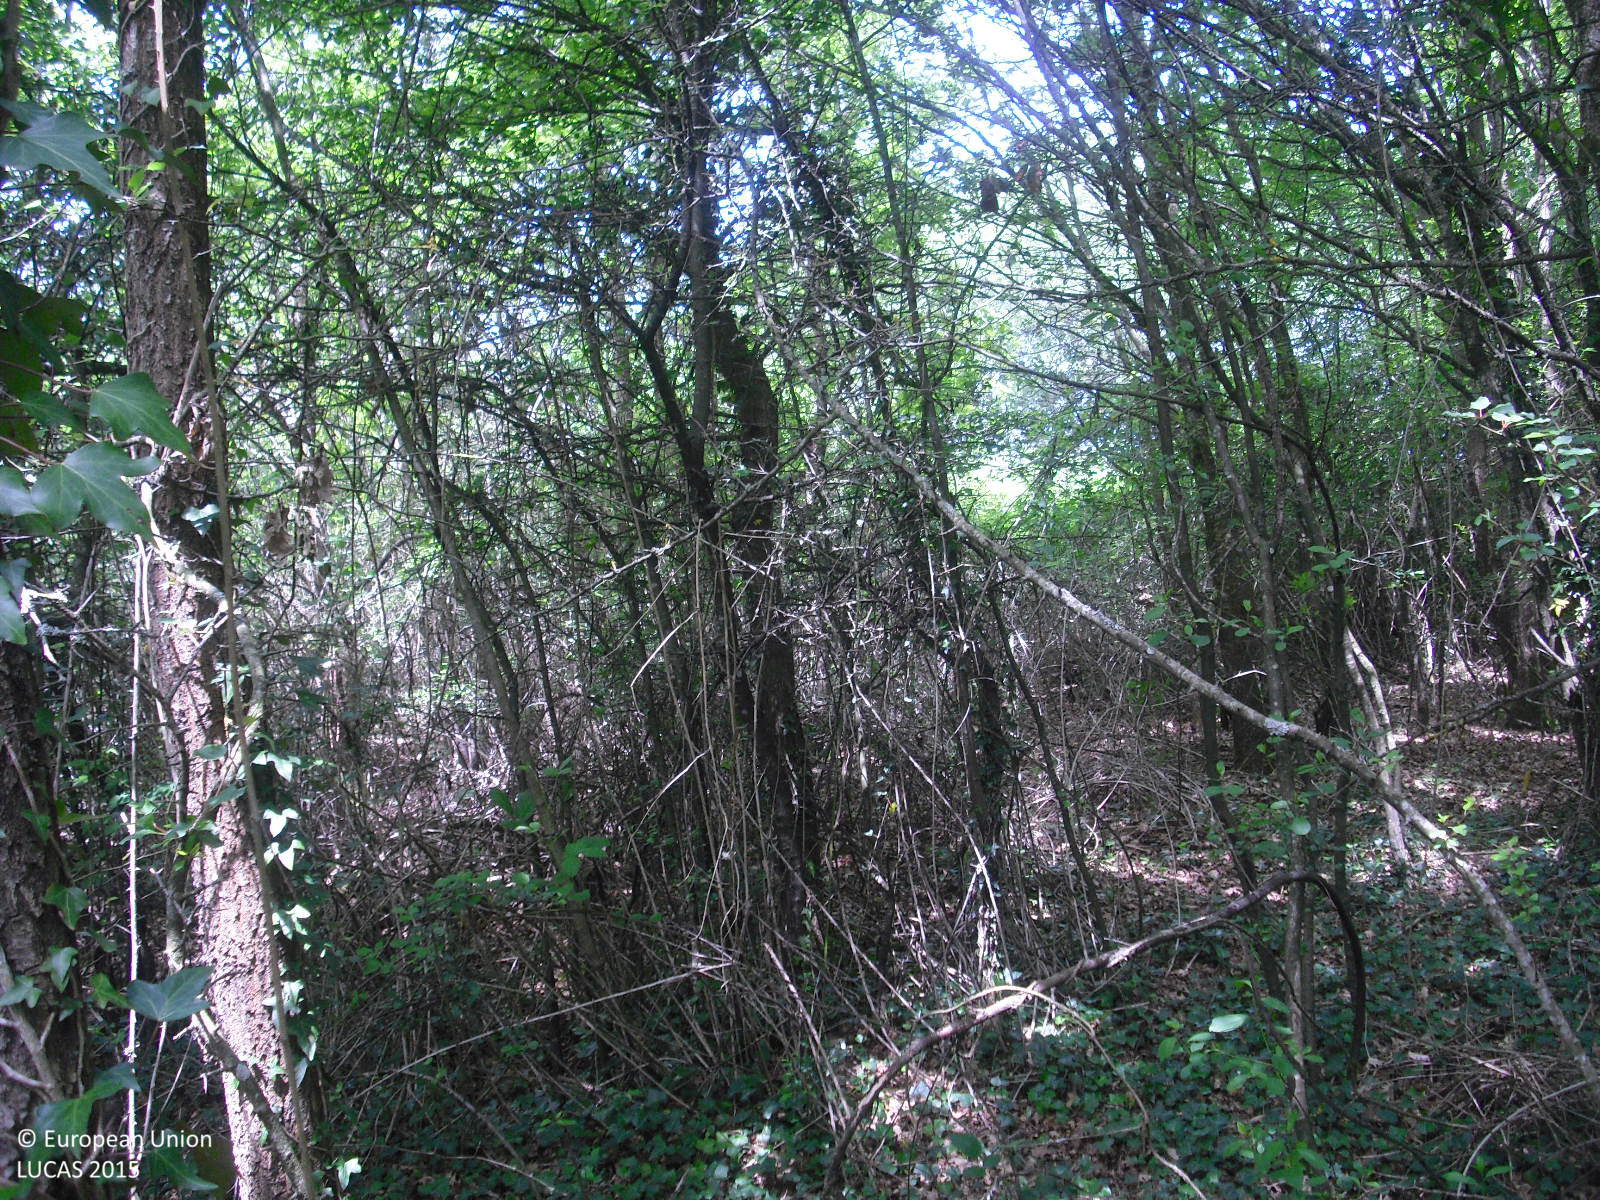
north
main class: Woodland
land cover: Broadleaved woodland
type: acidophilous oak and oak-birch forest
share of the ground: > 75 %
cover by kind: broadleaved forest trees 80 %, shrubs 20 %
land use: Abandoned areas
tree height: > 5 m
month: May
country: ES
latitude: 42.0938
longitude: -7.8090
